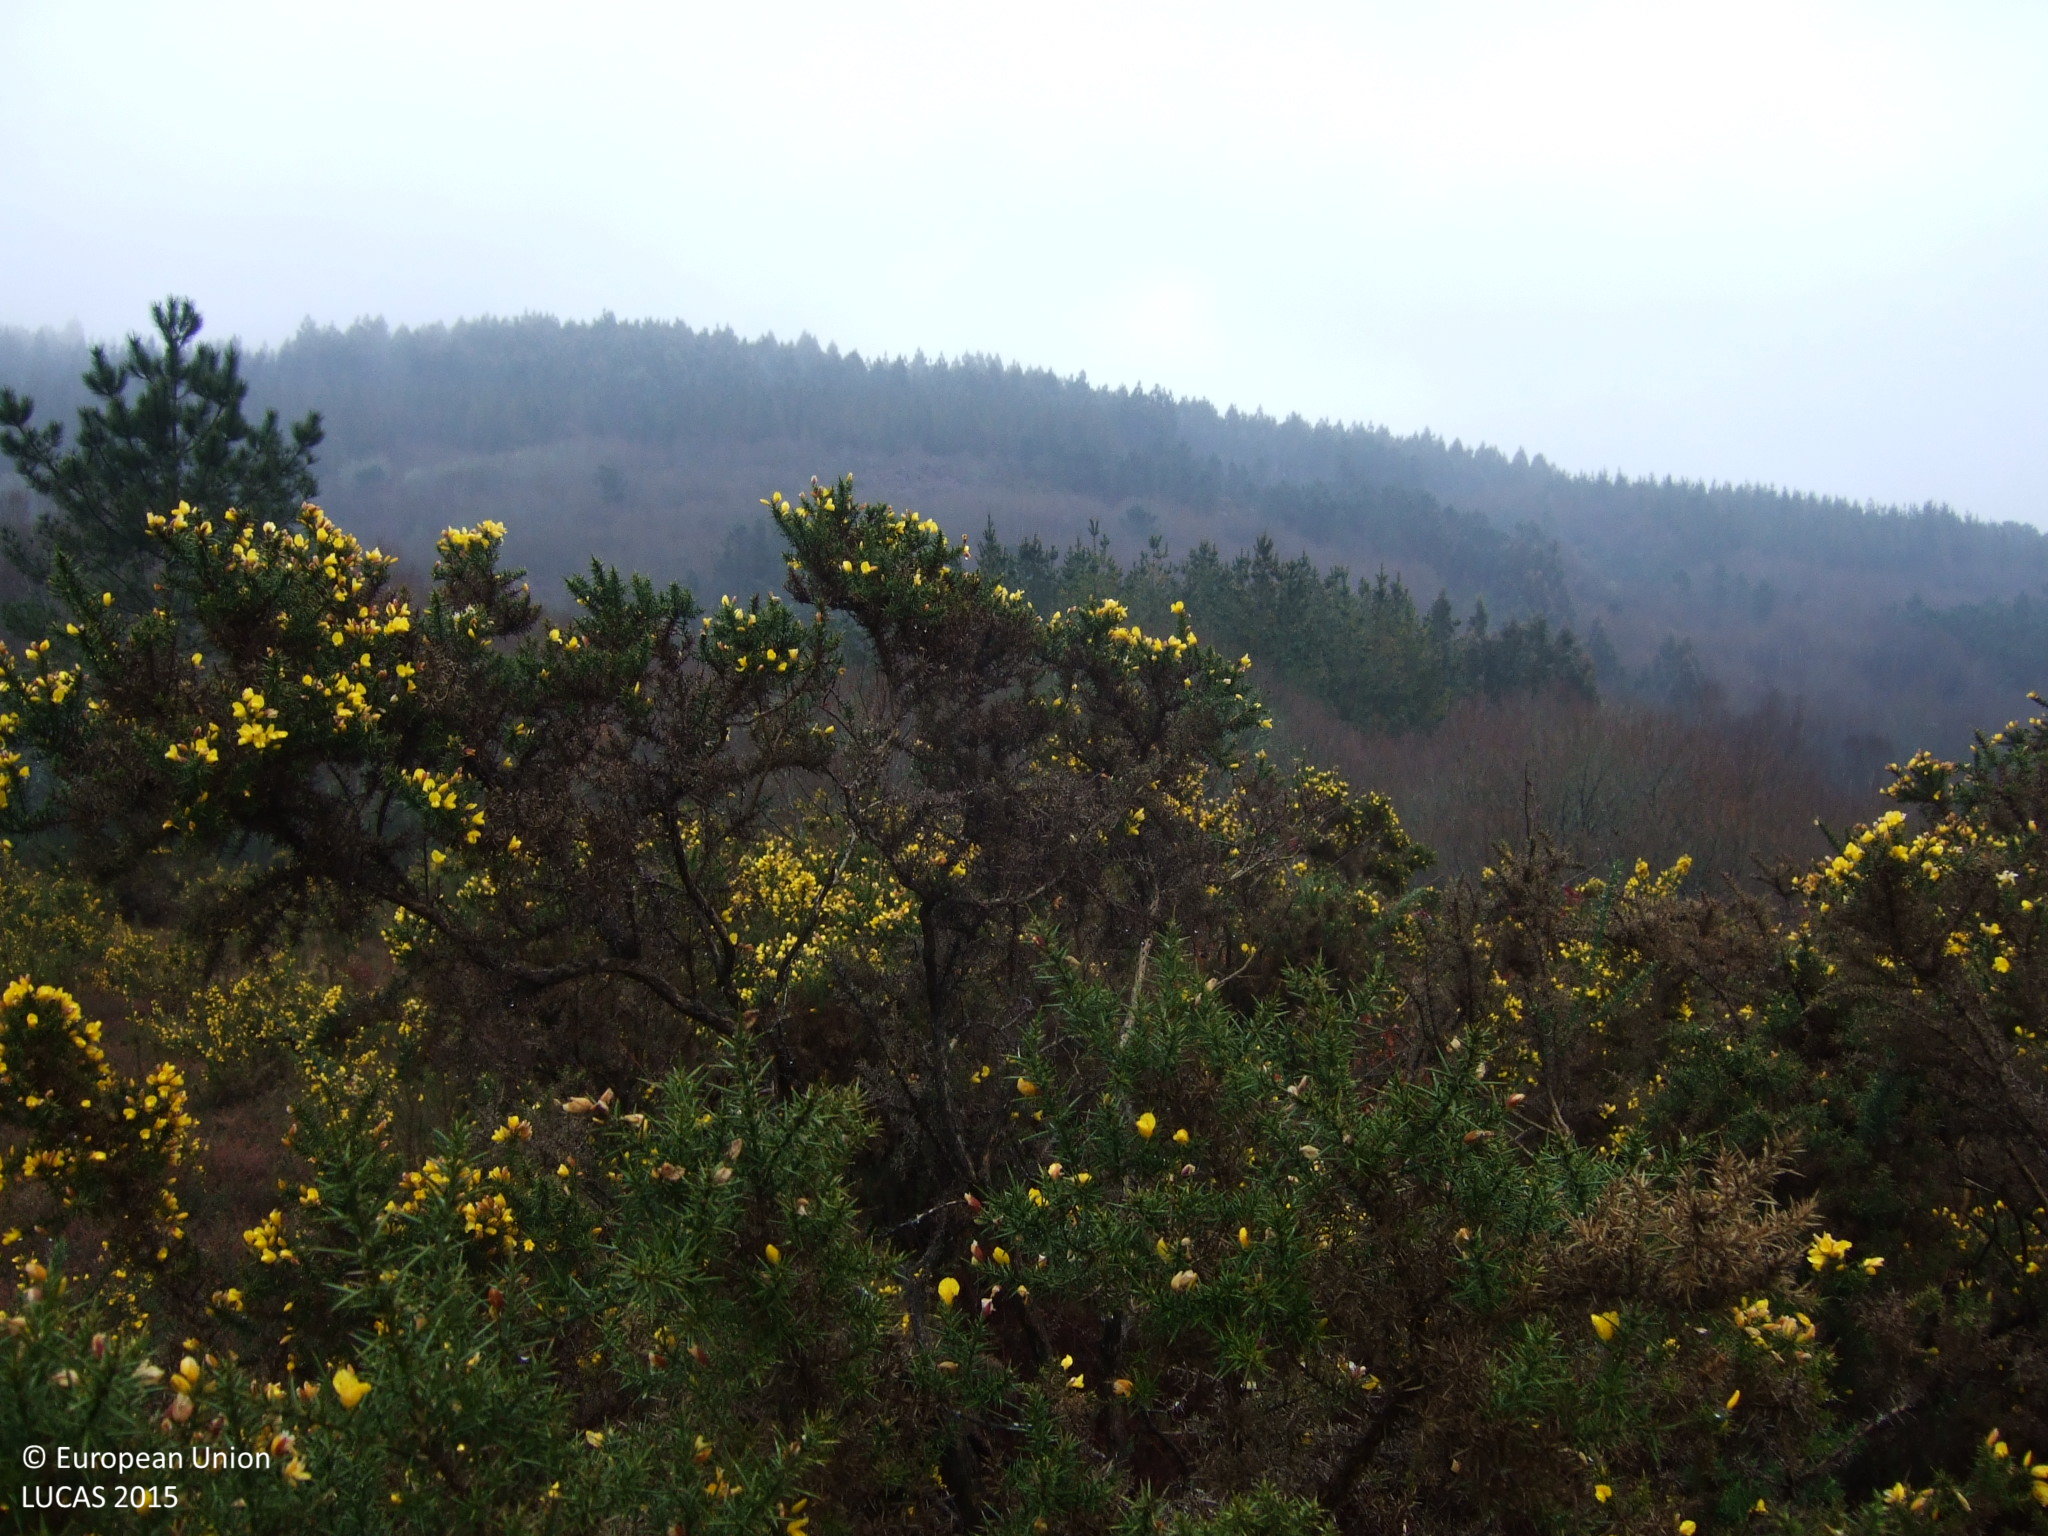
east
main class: Shrubland
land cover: Shrubland without tree cover
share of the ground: > 75 %
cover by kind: shrubs 100 %
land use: Semi-natural and natural areas not in use
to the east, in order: Shrubland without tree cover; Tracks; Shruby margins; Broadleaved woodland; Groves; Shruby margins; Grassland without tree/shrub cover
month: March
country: ES
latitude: 42.8624
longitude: -7.8429
